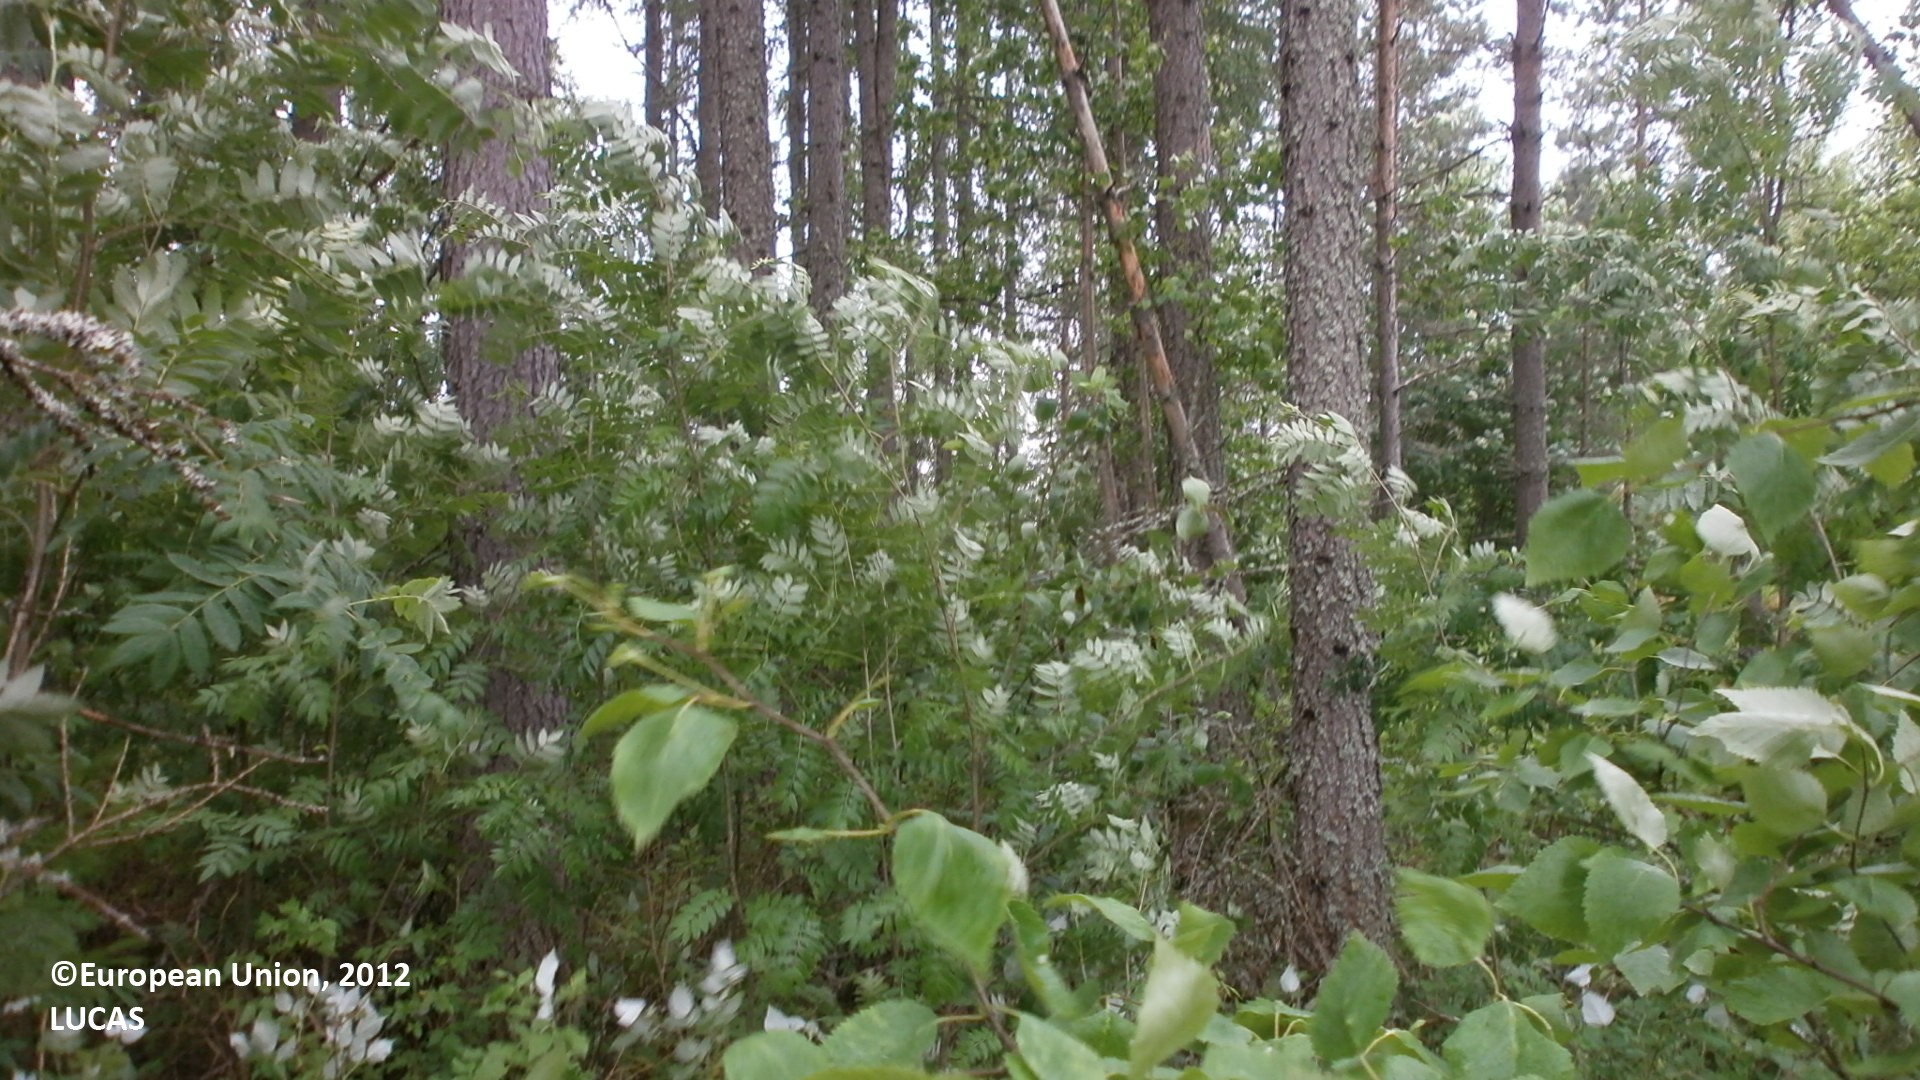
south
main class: Woodland
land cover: Other coniferous woodland
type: boreal forest
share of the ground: 50 - 75 %
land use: Forestry
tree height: > 5 m
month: June
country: FI
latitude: 64.6144
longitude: 25.0687
